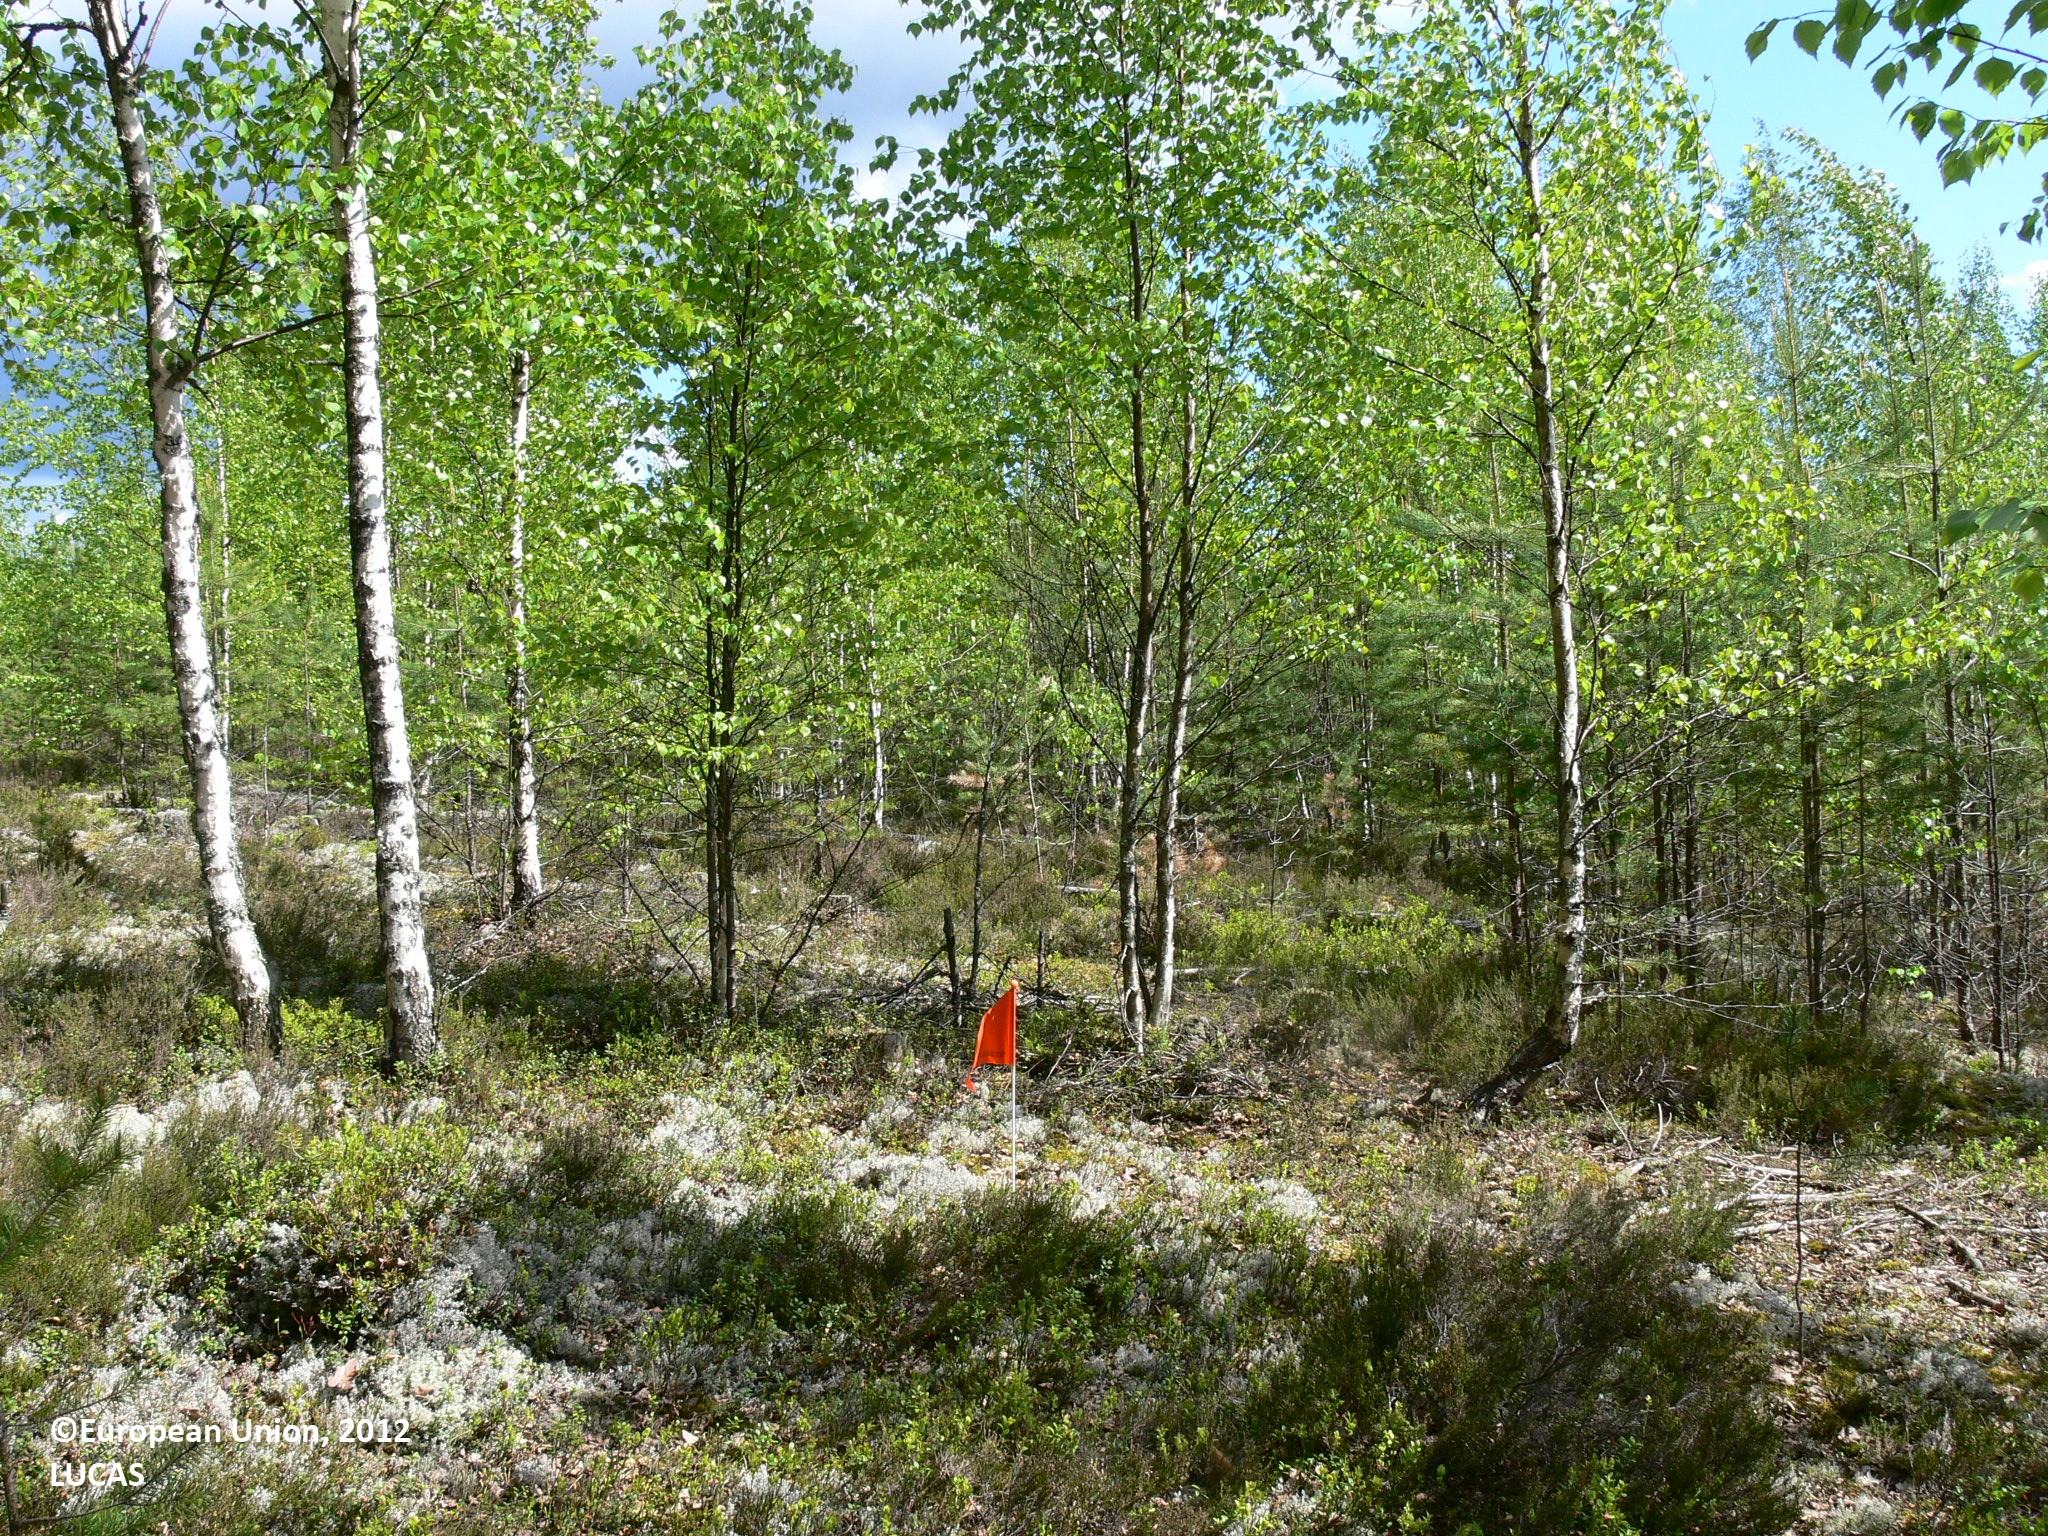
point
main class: Woodland
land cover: Other mixed woodland
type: boreal forest
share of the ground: > 75 %
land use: Forestry
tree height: < 5 m
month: June
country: FI
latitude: 62.6712
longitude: 29.7122
